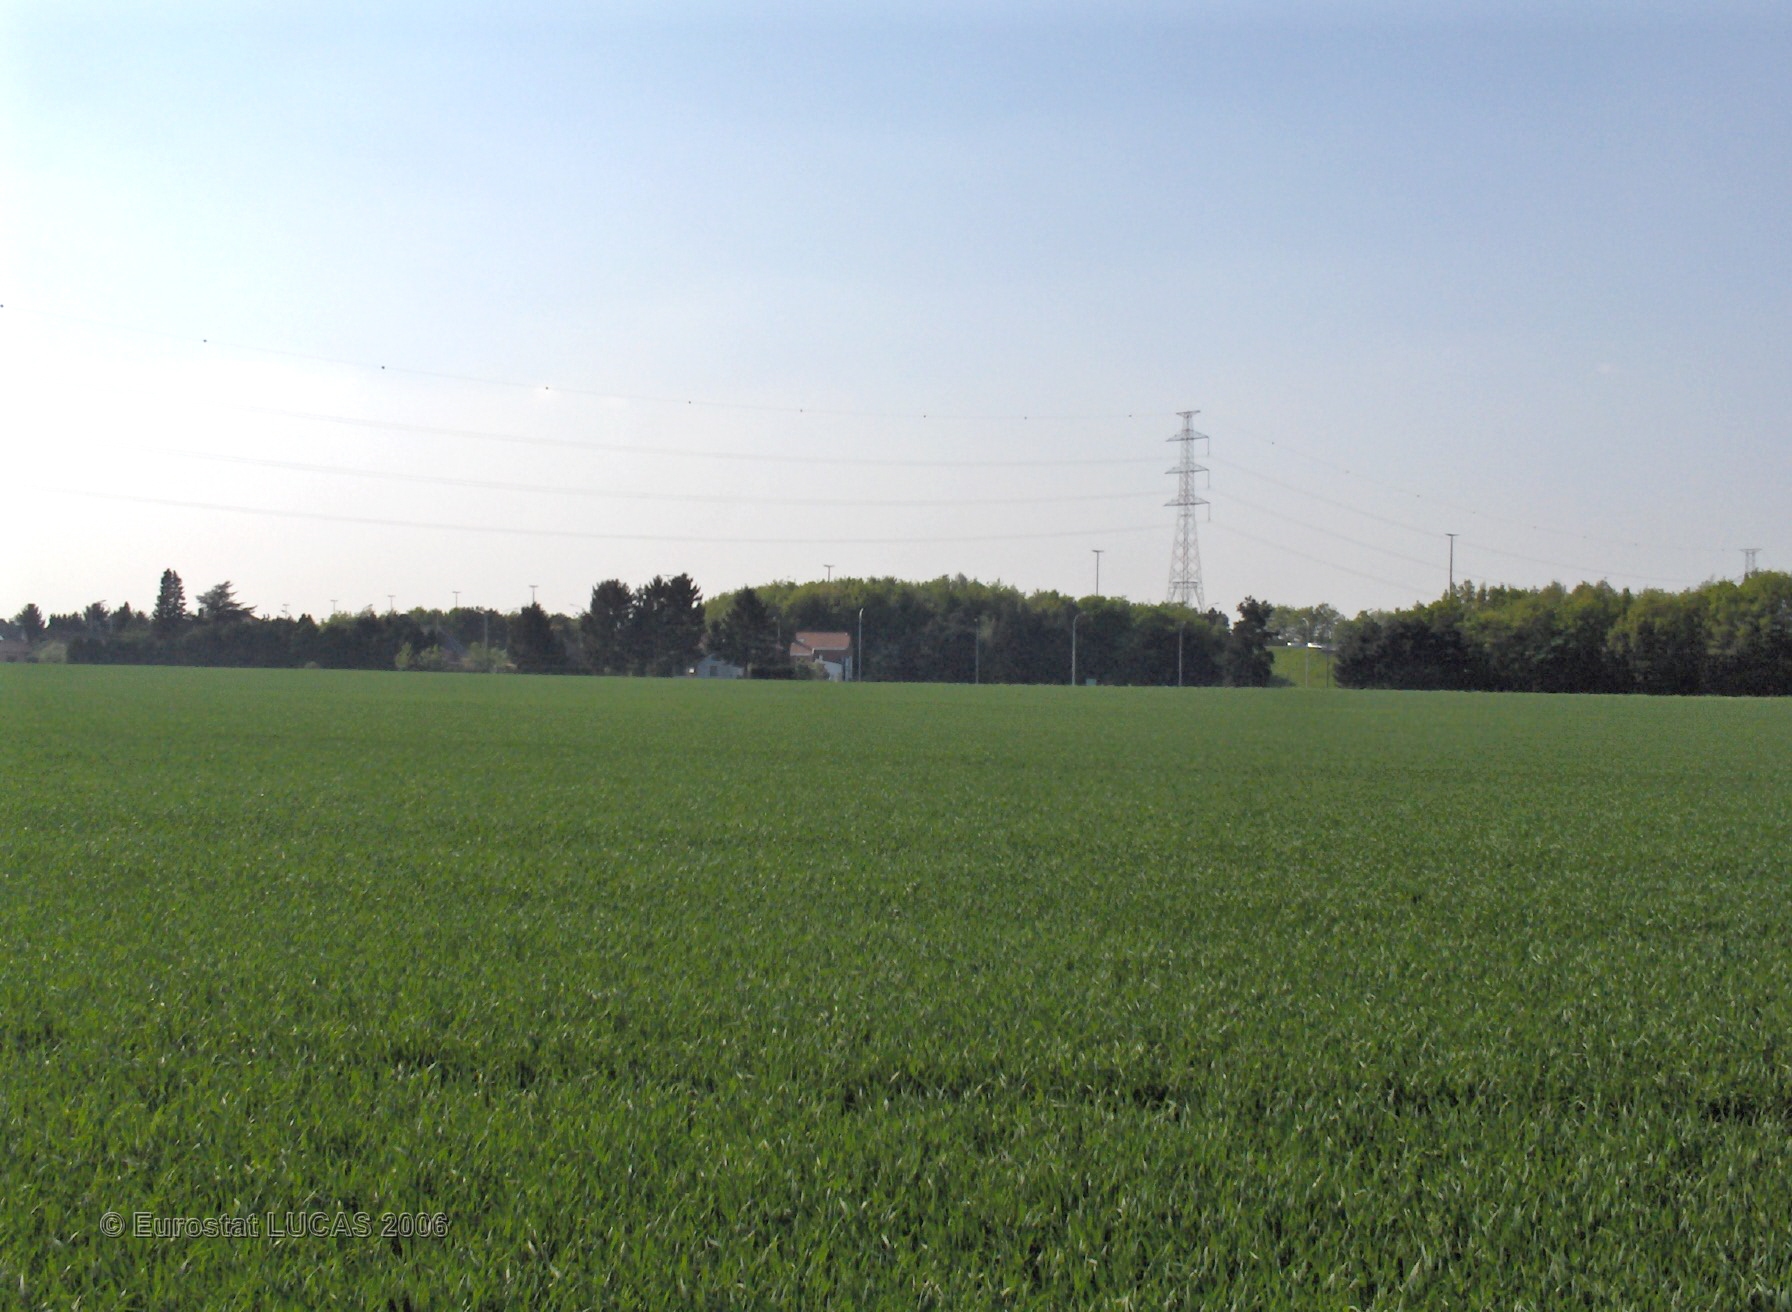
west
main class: Cropland
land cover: Common wheat
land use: Agriculture (excluding fallow land and kitchen gardens)
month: May
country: BE
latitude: 50.4682
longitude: 4.5436
